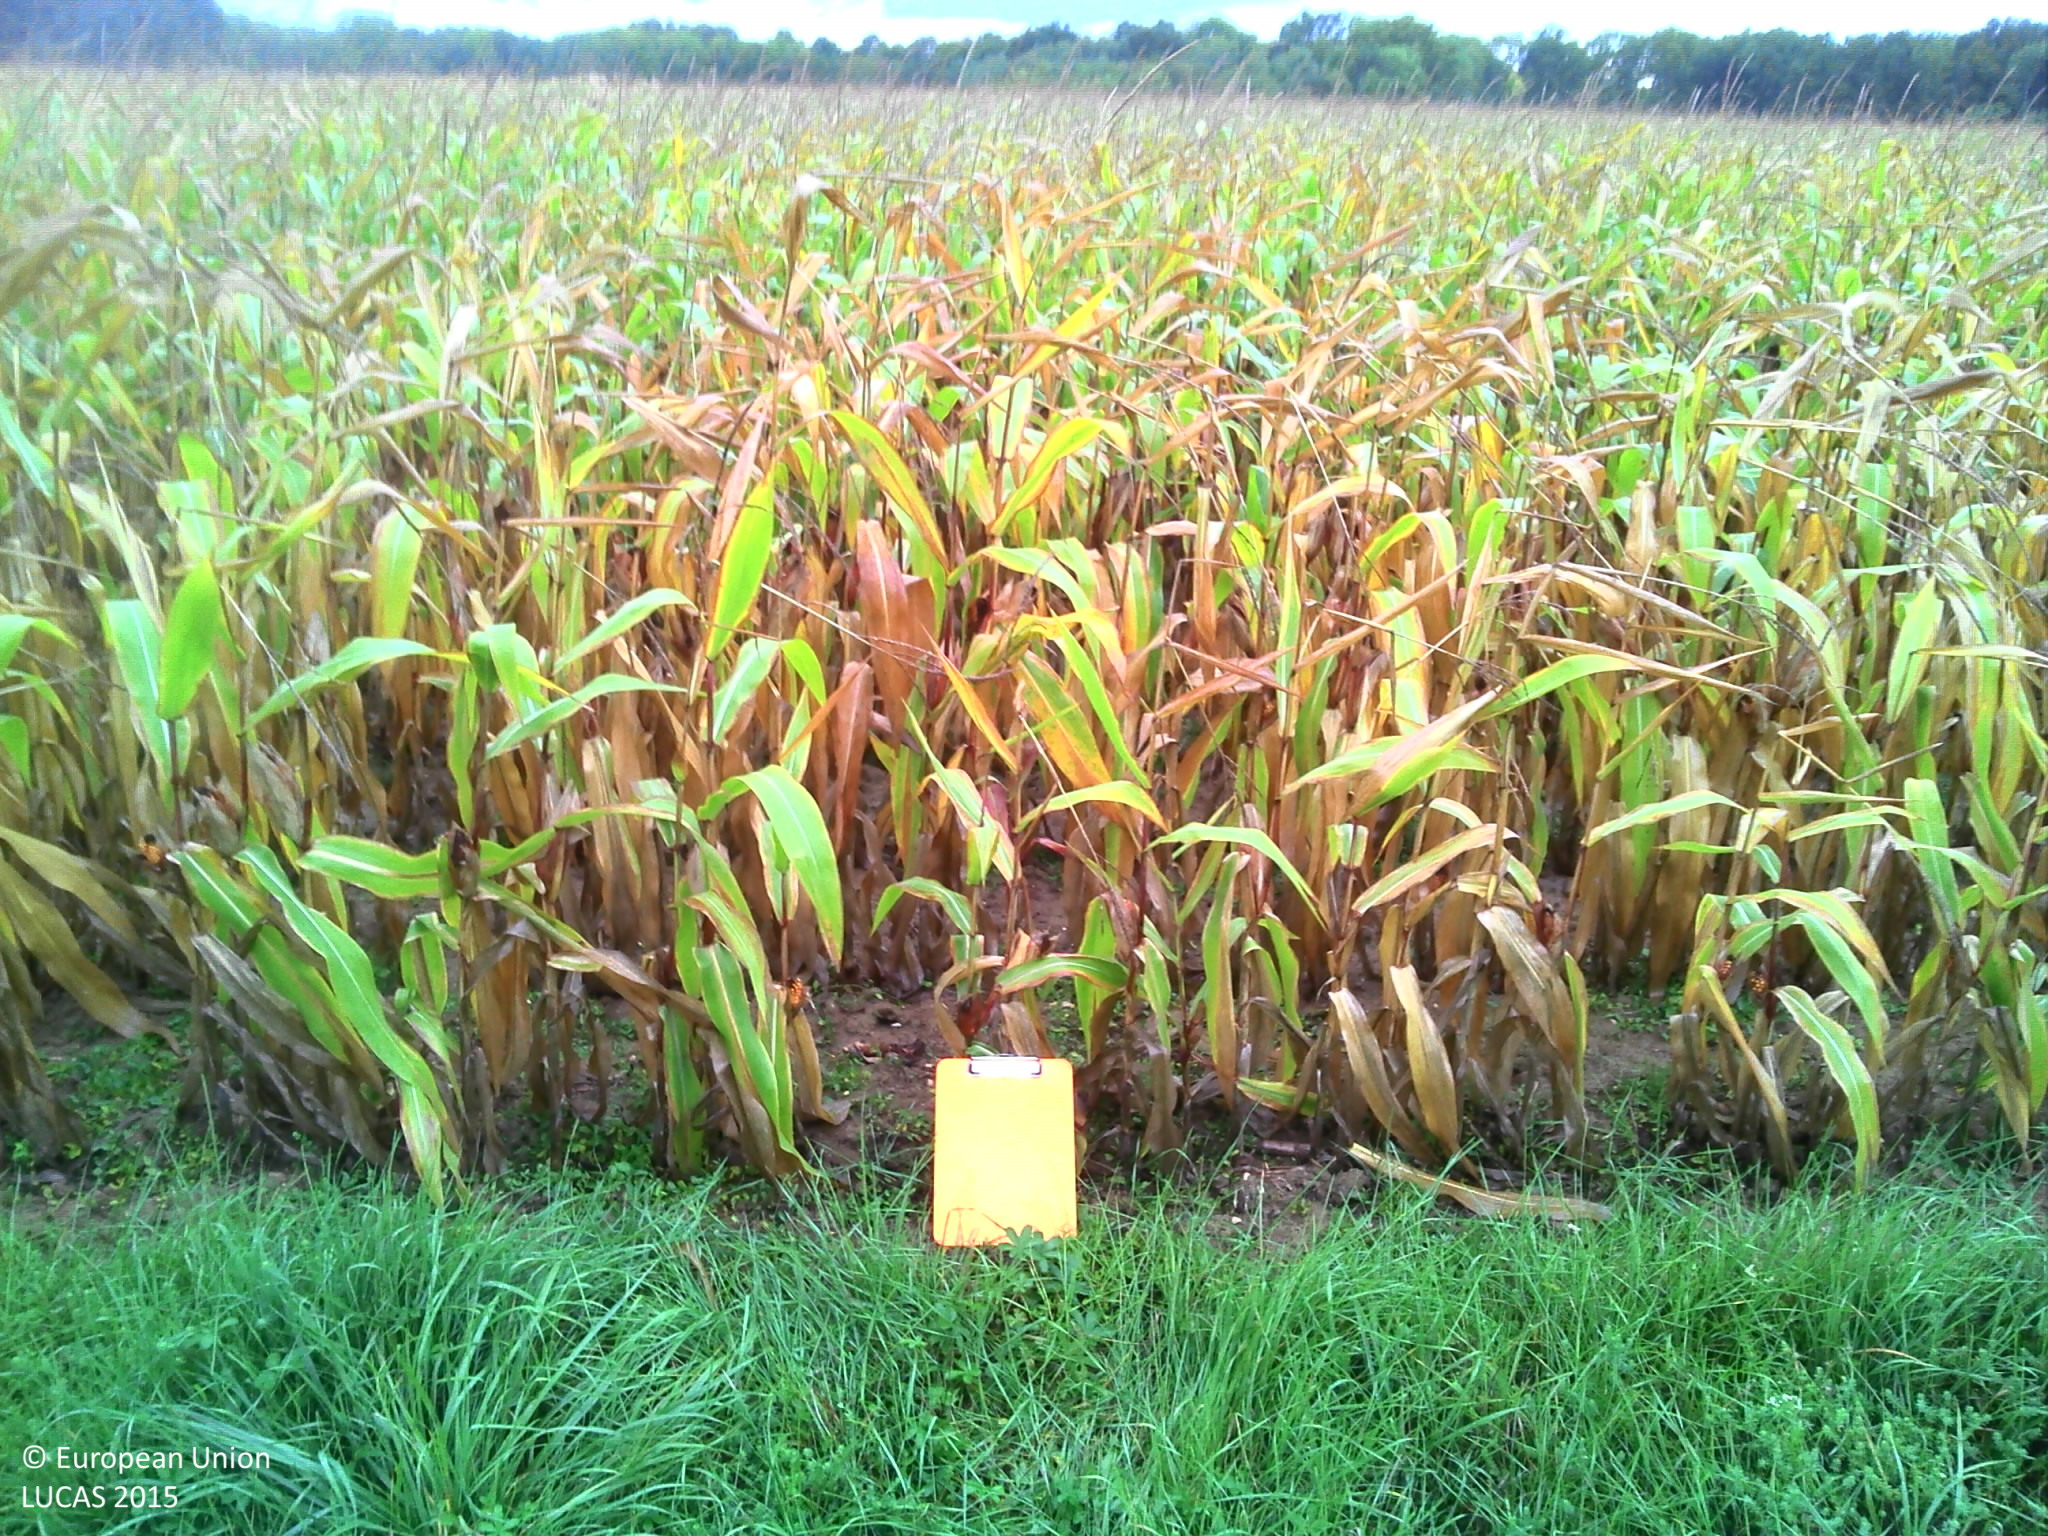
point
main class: Cropland
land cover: Maize
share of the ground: > 75 %
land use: Agriculture (excluding fallow land and kitchen gardens)
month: October
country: FR
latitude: 48.2329
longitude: 4.1942
